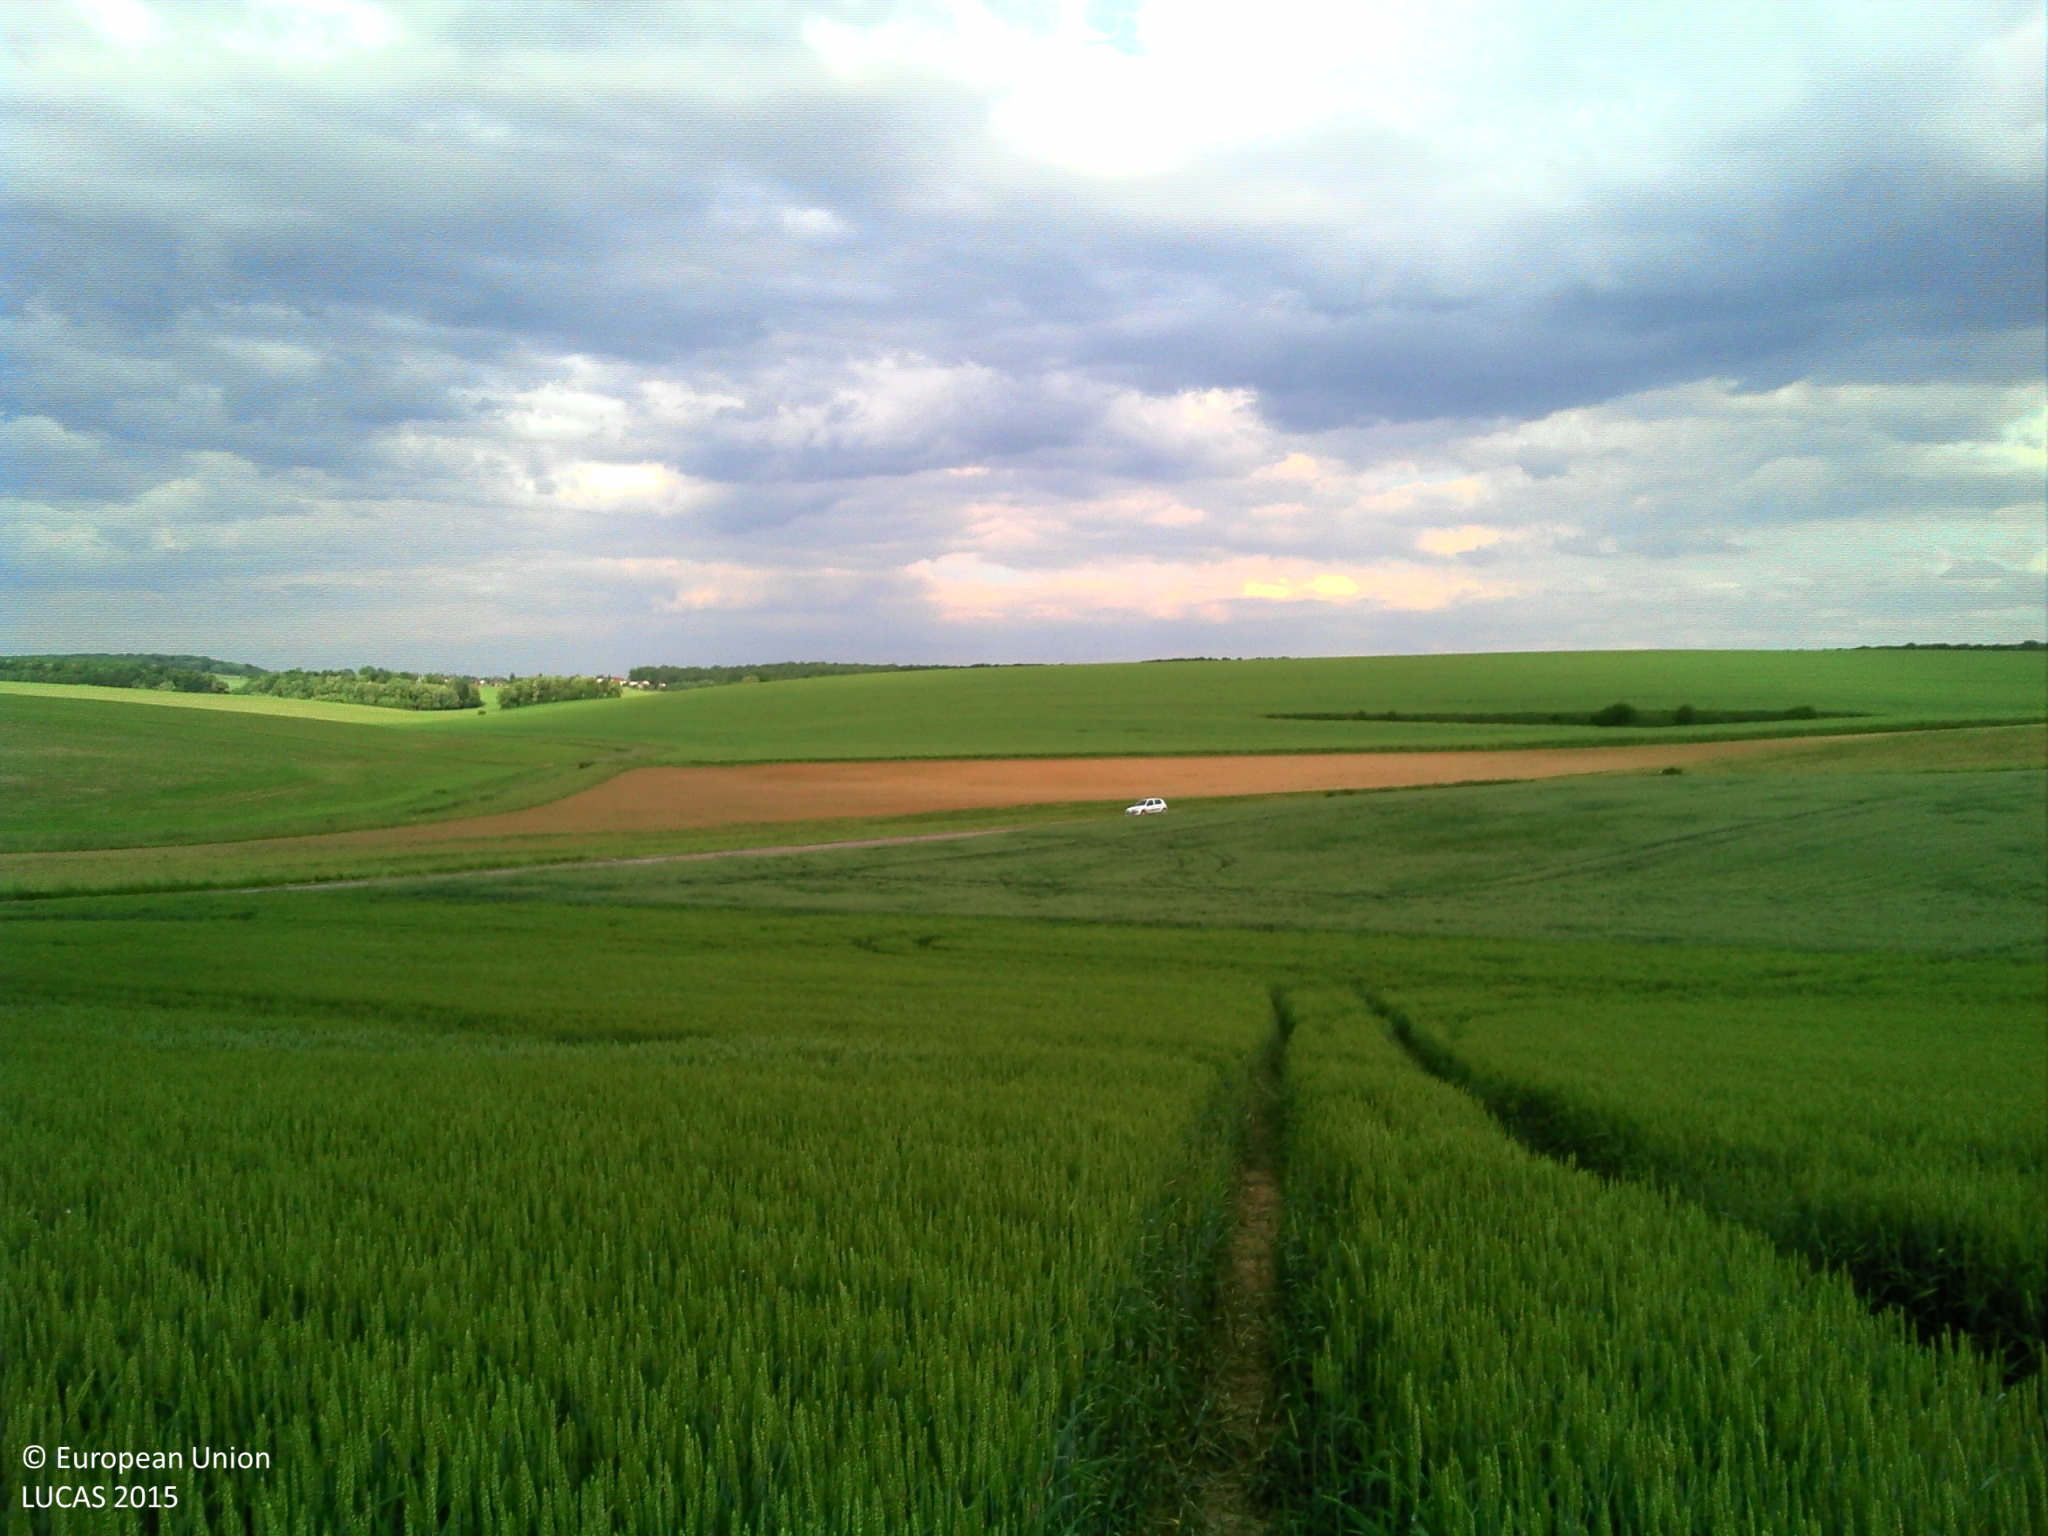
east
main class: Cropland
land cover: Common wheat
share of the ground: > 75 %
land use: Agriculture (excluding fallow land and kitchen gardens)
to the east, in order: Common wheat; Triticale; Grass margins; Ditches and canals; Grass margins; Paved roads, cycling and walking lanes; Grass margins; Maize; Sunflower
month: May
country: FR
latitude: 47.8818
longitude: 6.0292
